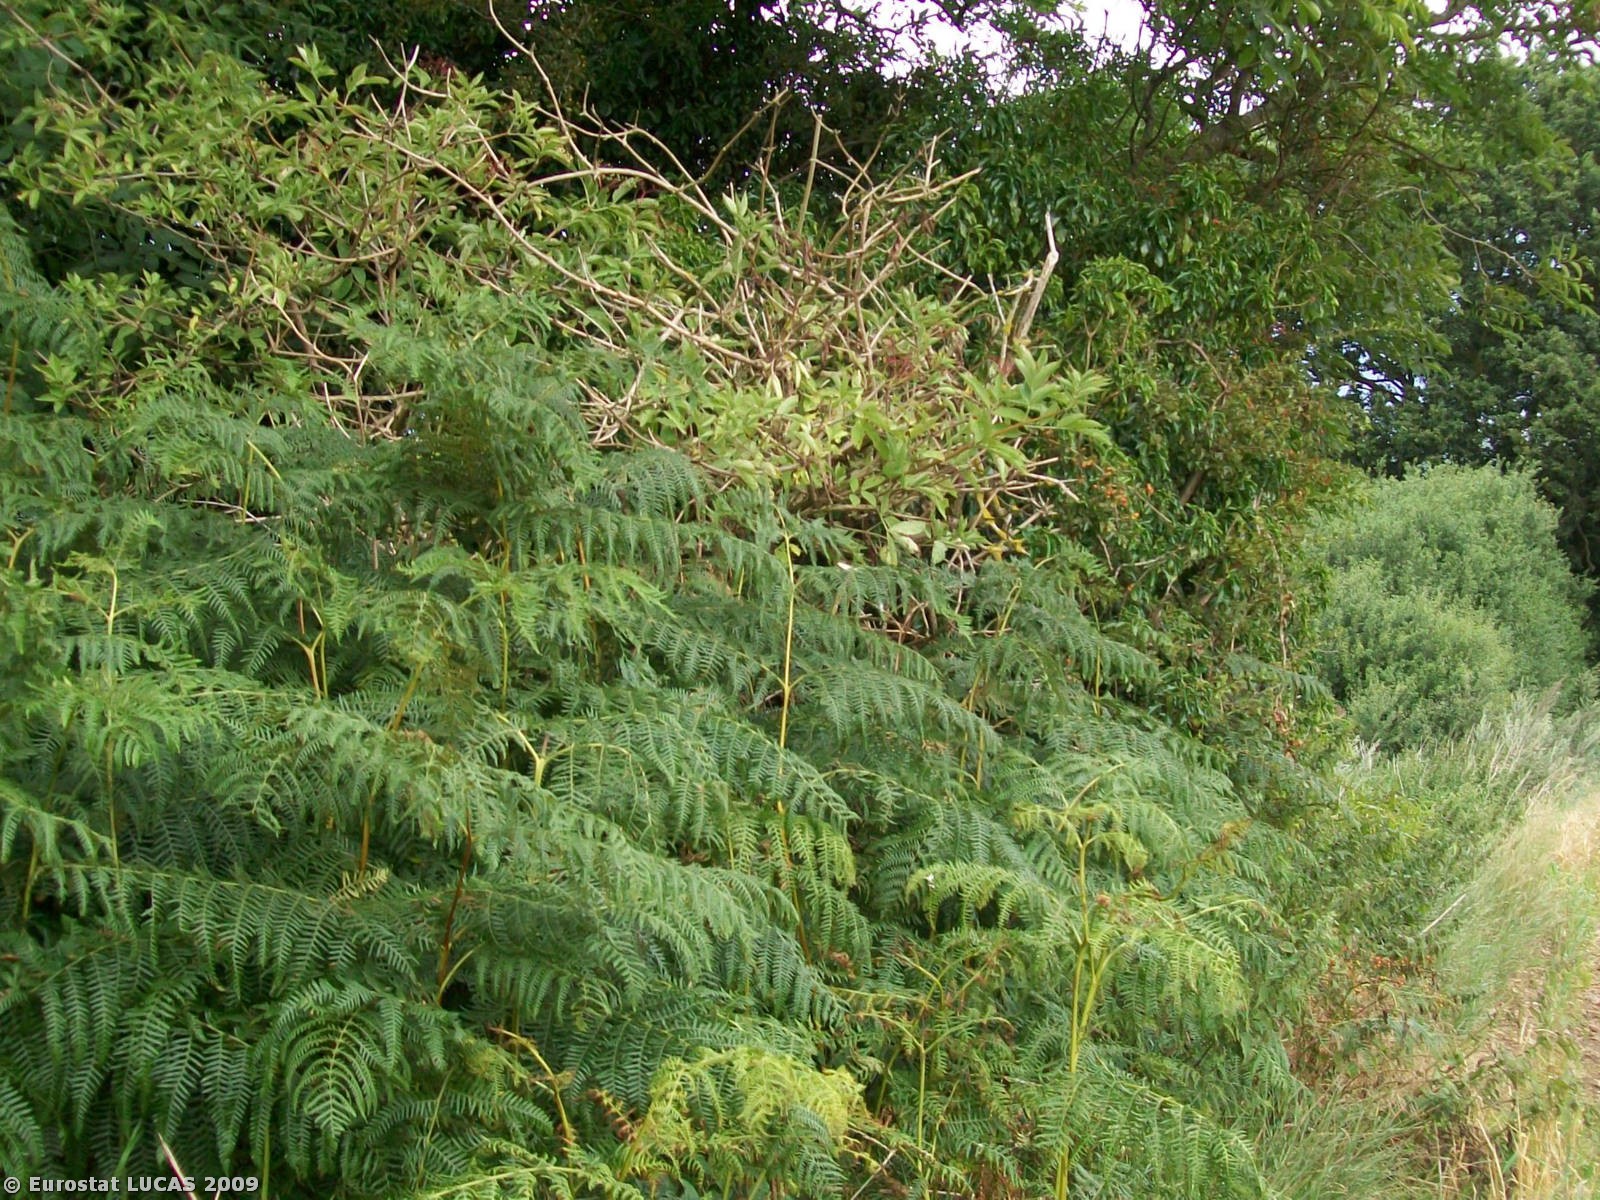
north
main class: Cropland
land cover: Barley
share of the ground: > 75 %
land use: Agriculture (excluding fallow land and kitchen gardens)
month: August
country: GB
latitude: 51.4777
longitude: -1.0601
